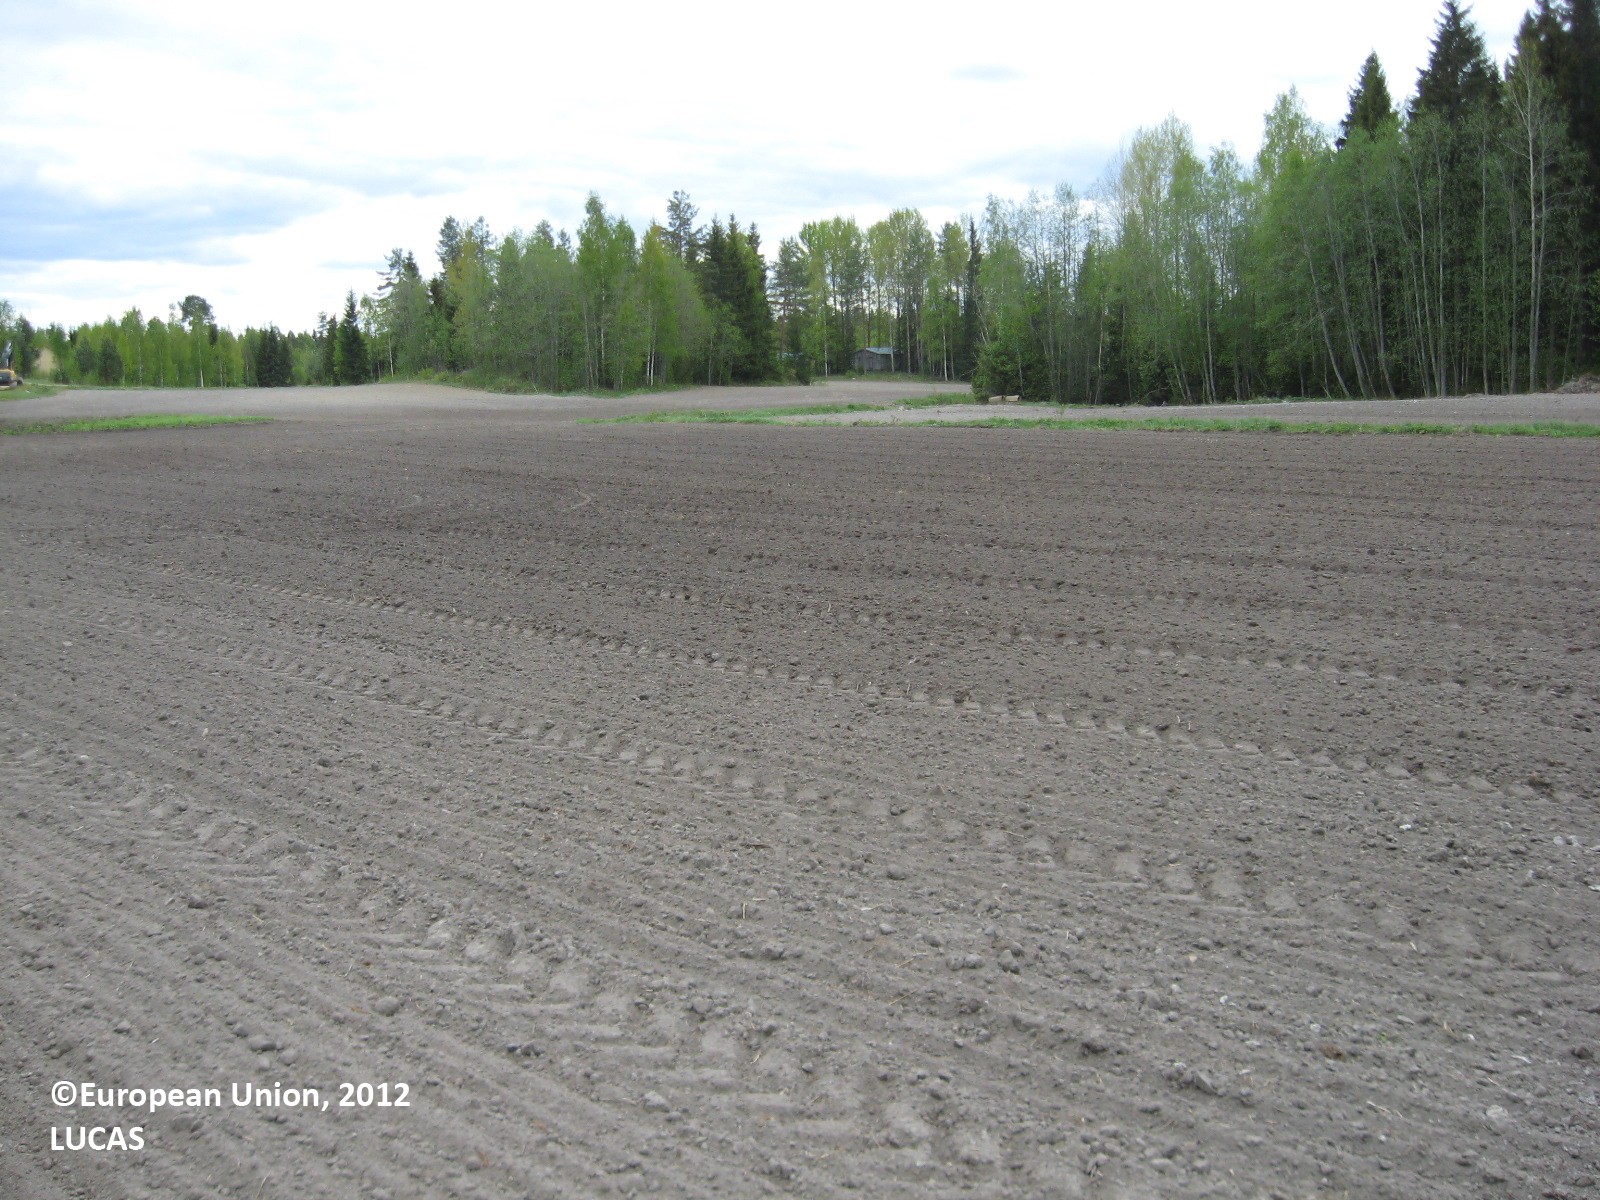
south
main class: Cropland
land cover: Oats
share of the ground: < 10 %
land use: Agriculture (excluding fallow land and kitchen gardens)
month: May
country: FI
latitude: 61.8040
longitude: 22.8343
